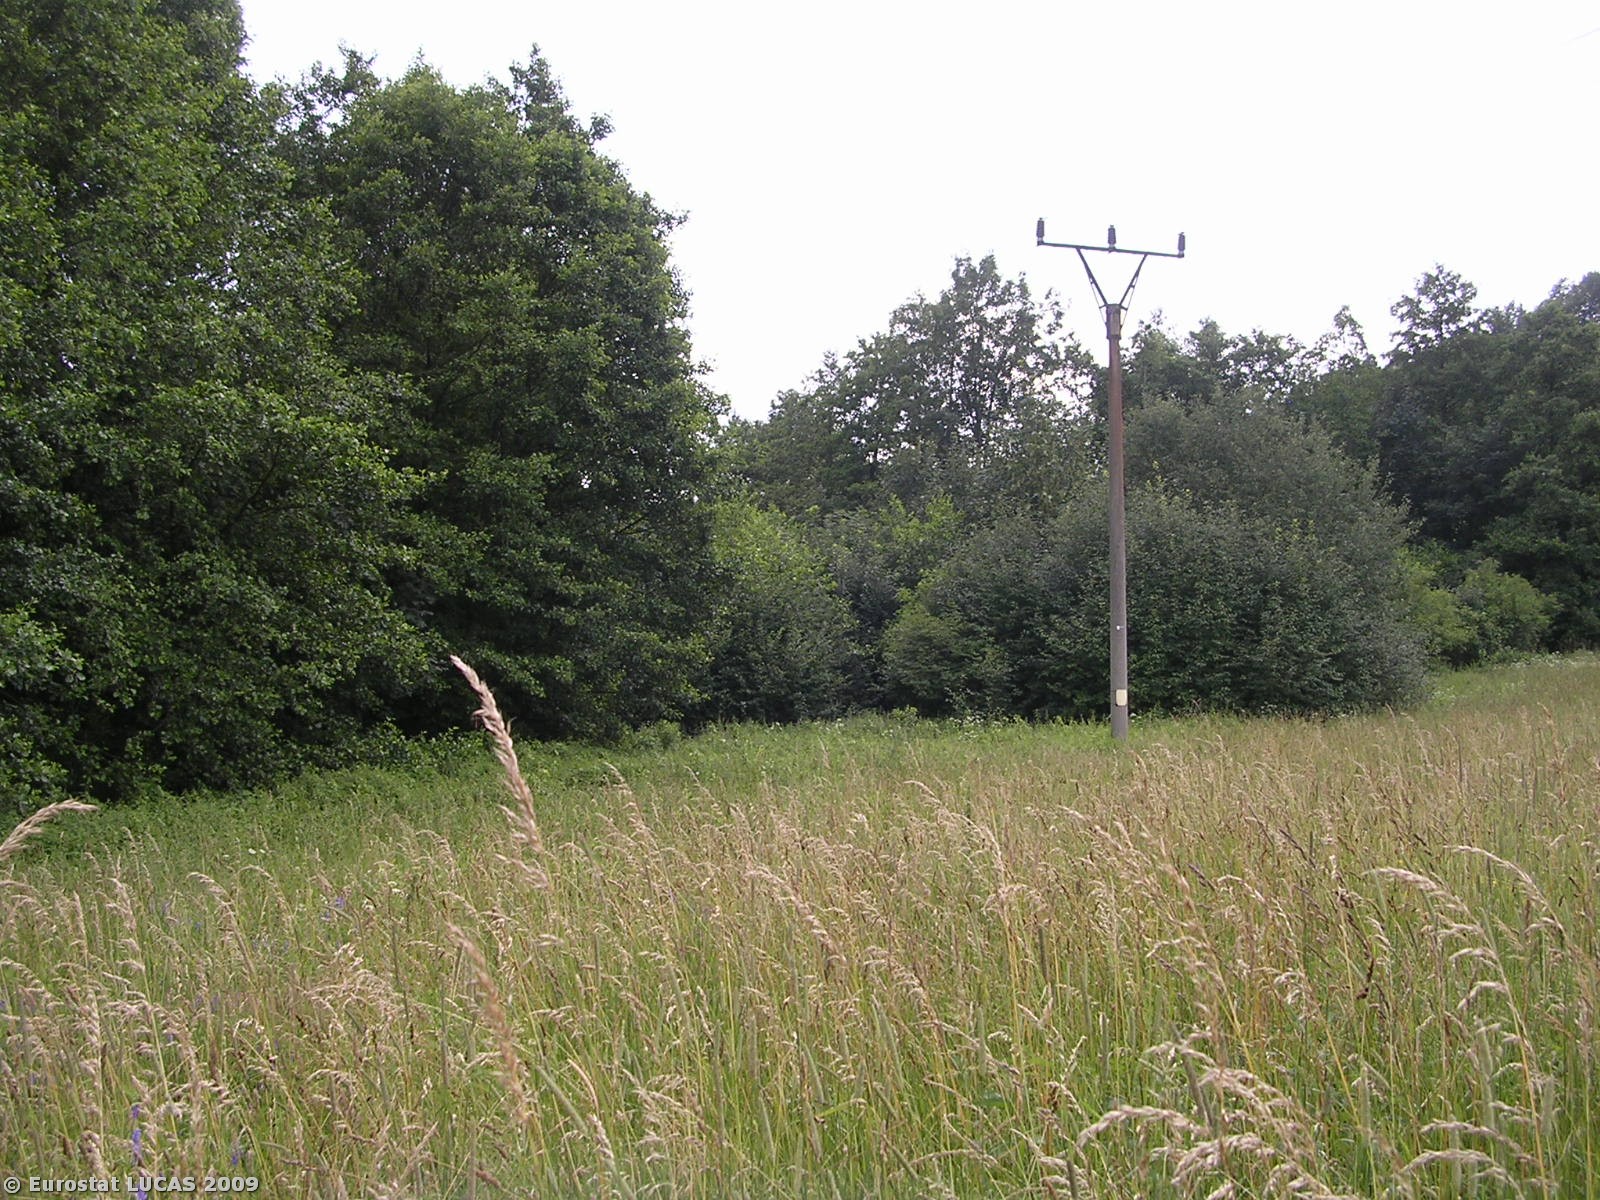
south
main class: Grassland
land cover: Grassland without tree/shrub cover
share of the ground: > 75 %
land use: Agriculture (excluding fallow land and kitchen gardens)
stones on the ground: < 10 %
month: July
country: CZ
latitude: 50.8528
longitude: 14.4763
